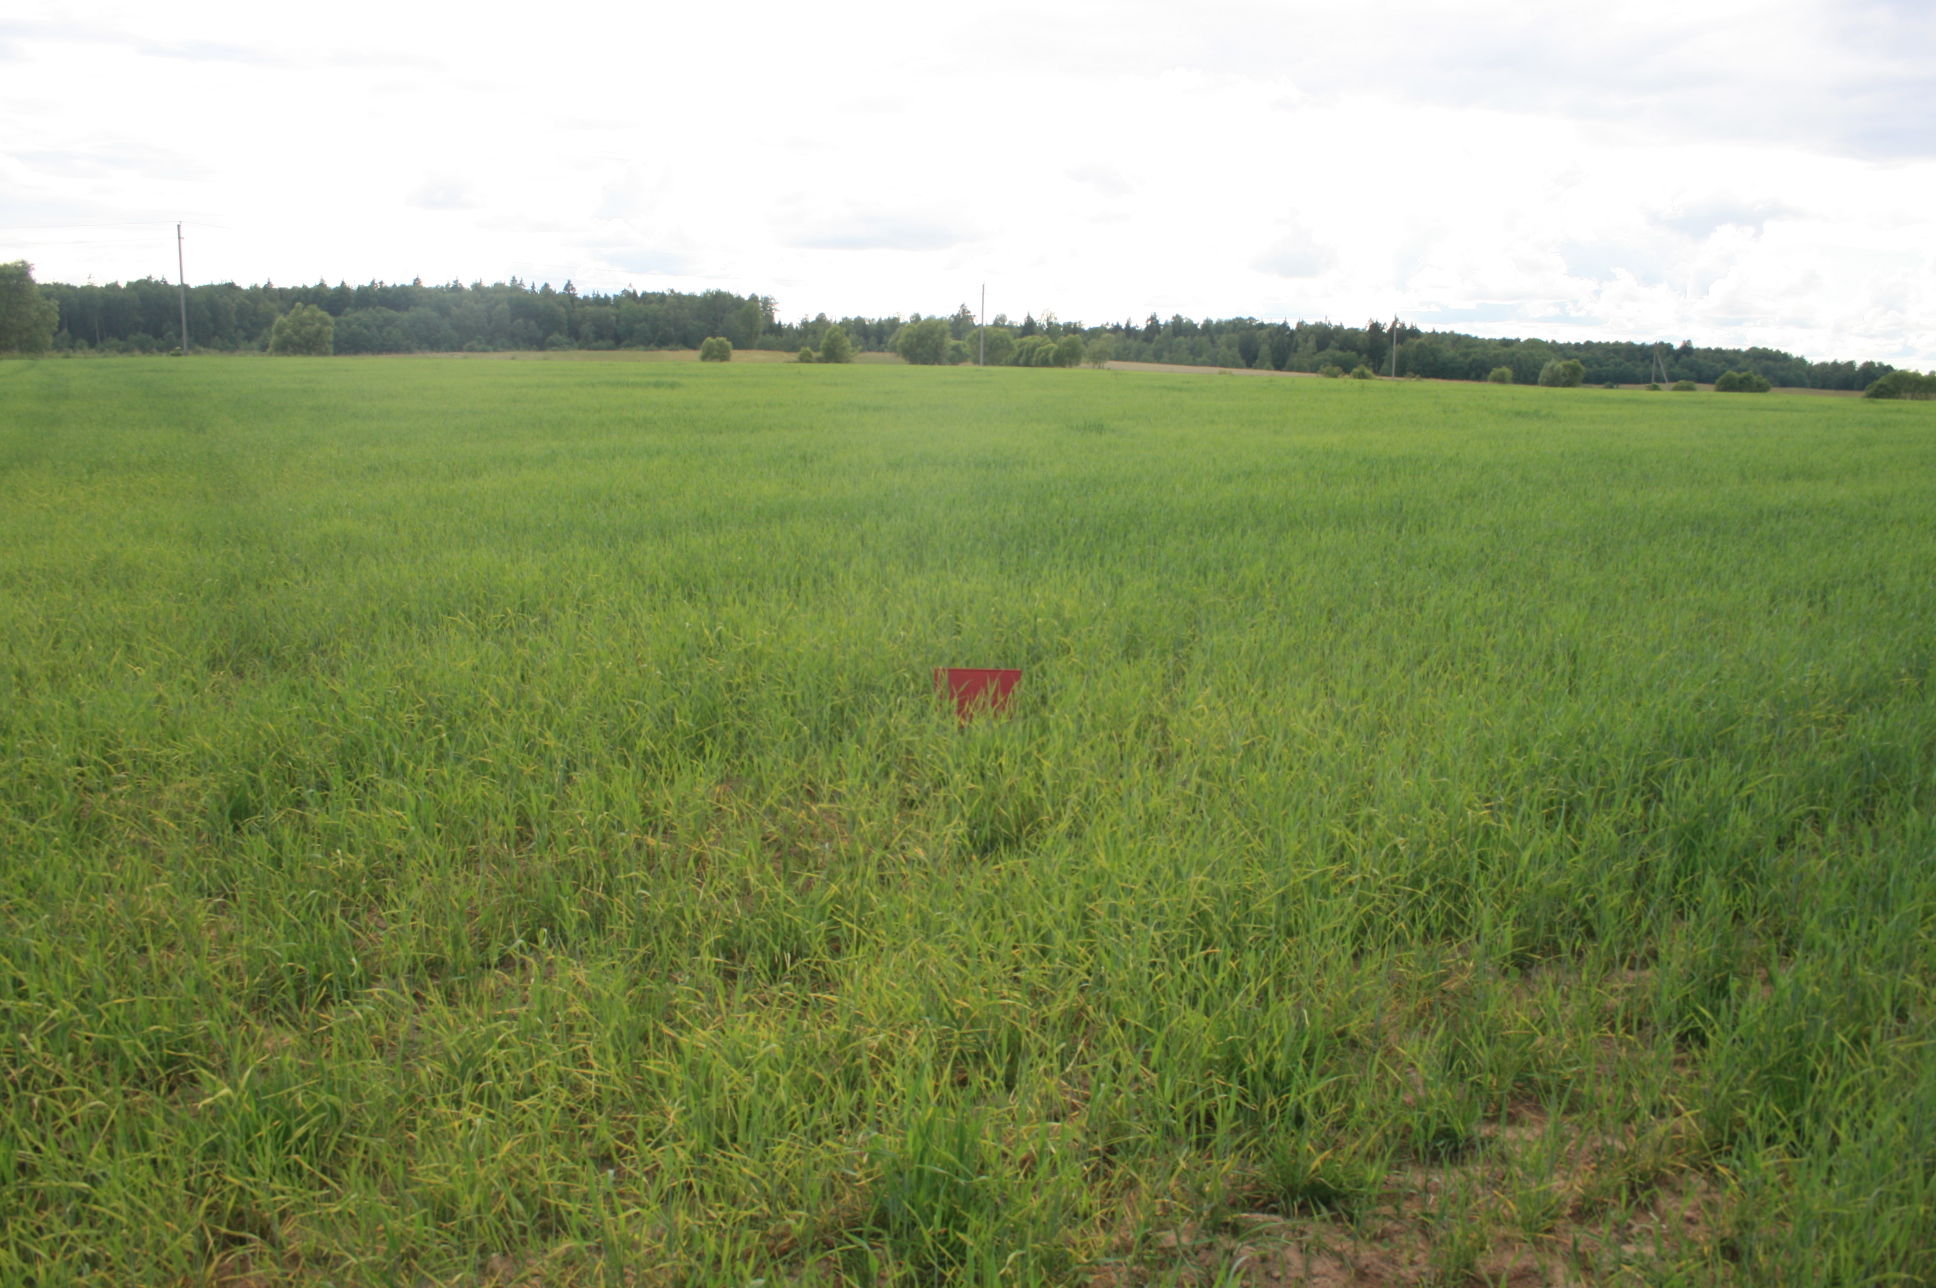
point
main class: Cropland
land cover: Barley
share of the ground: > 75 %
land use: Agriculture (excluding fallow land and kitchen gardens)
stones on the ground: < 10 %
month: June
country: LT
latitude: 55.1052
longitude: 22.0775
